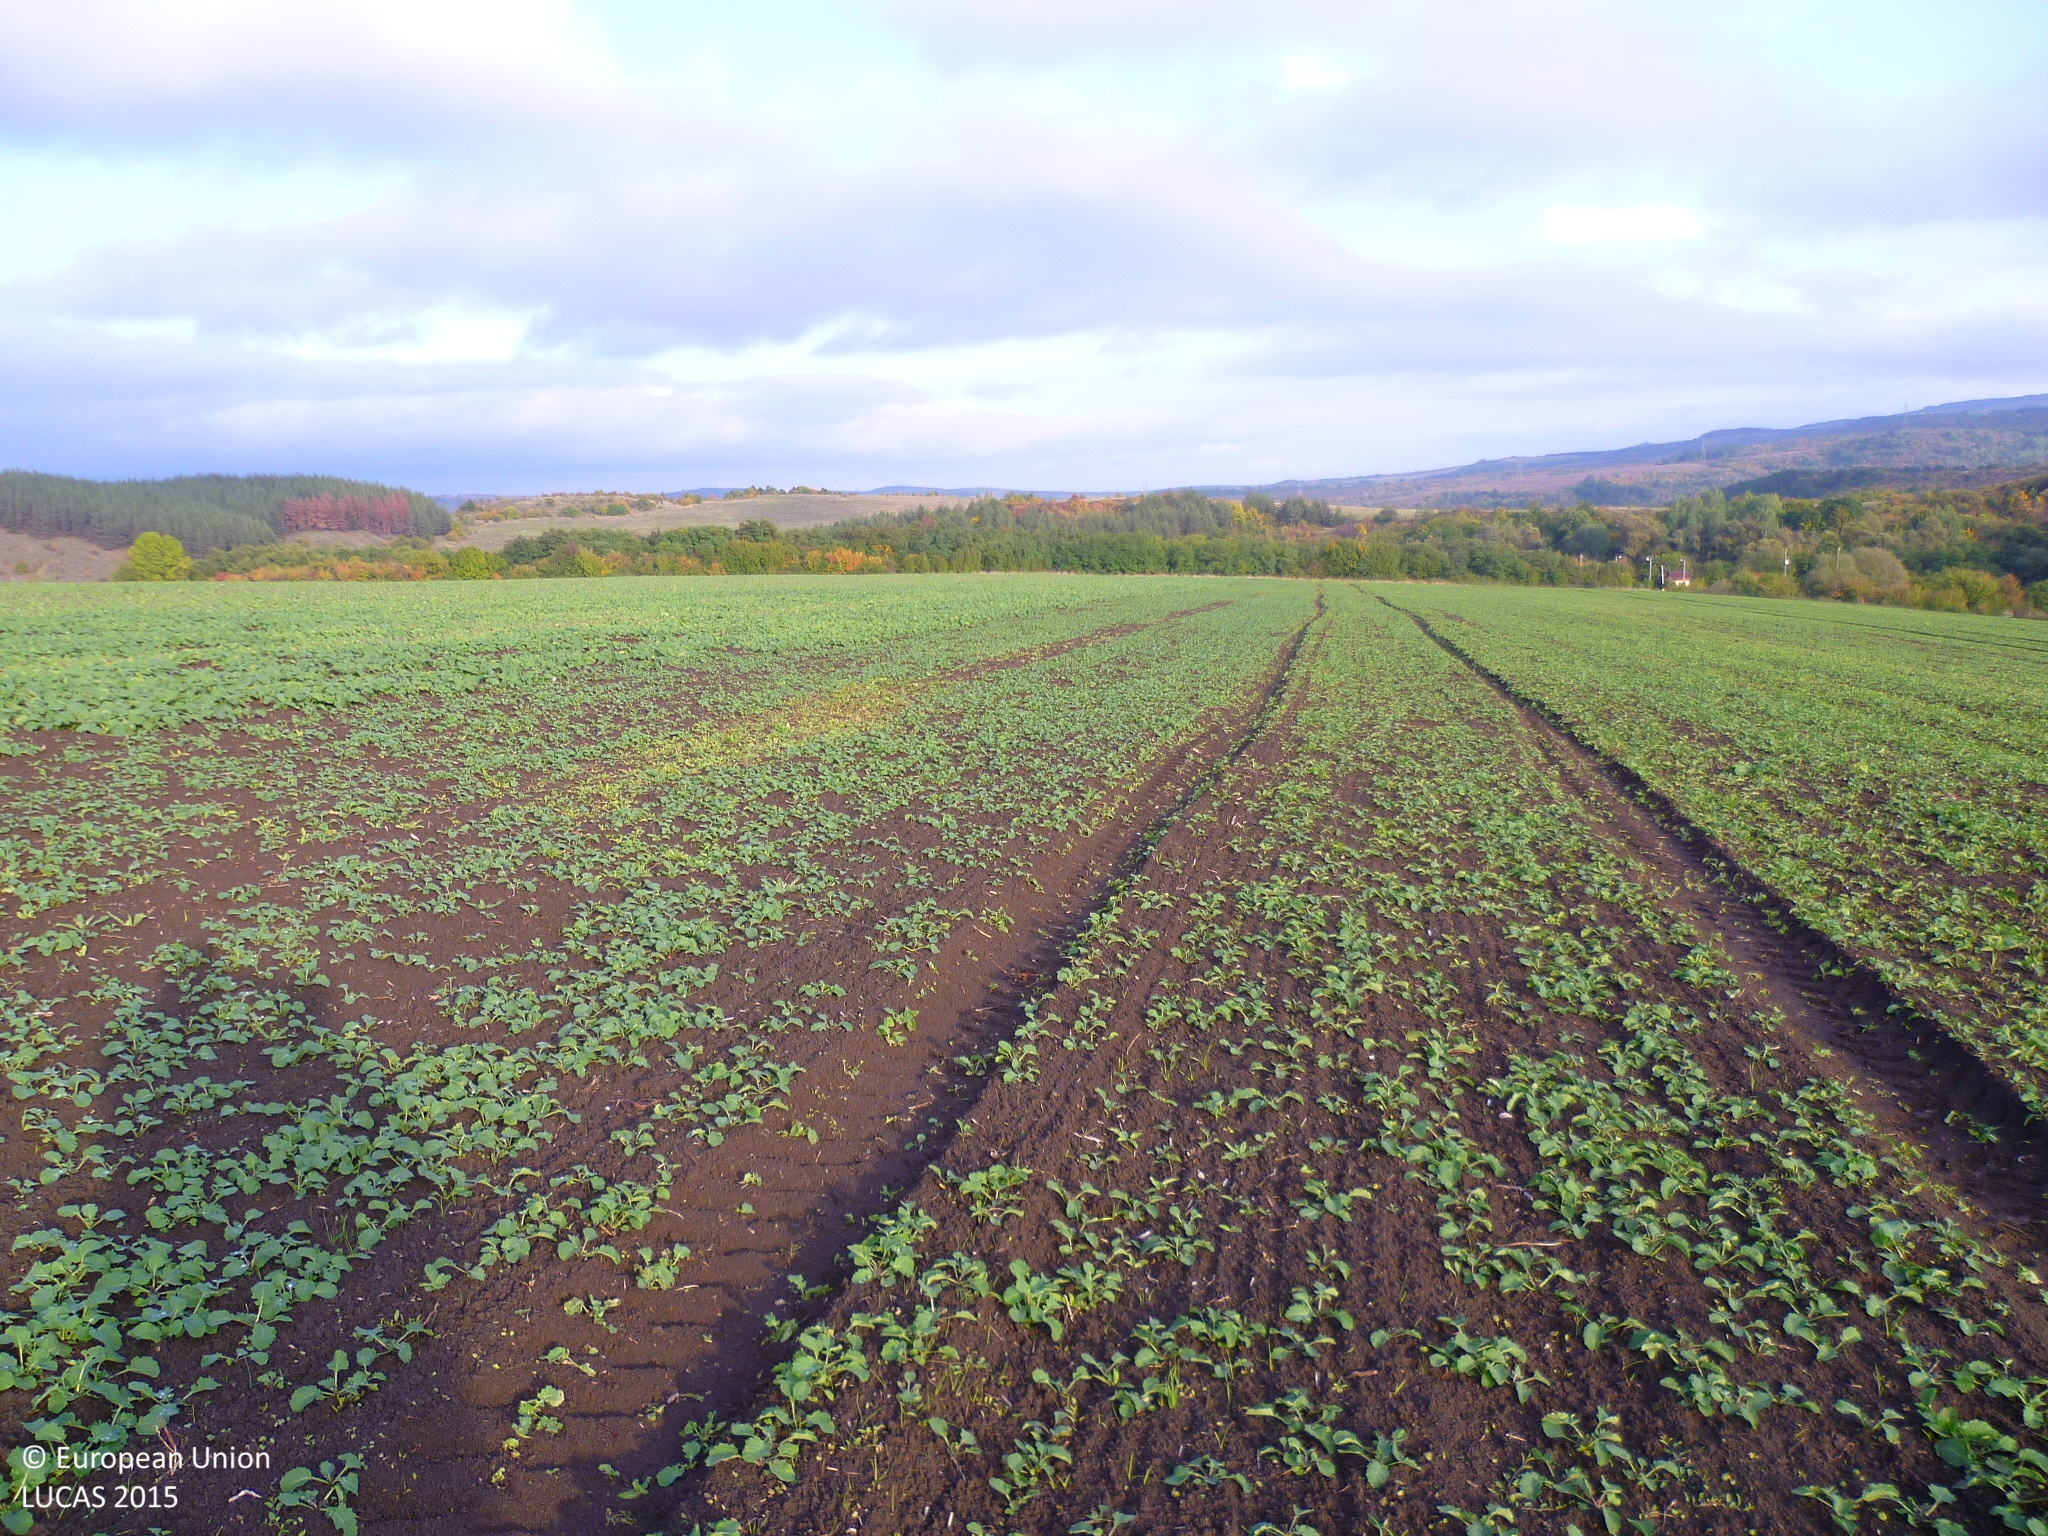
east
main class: Cropland
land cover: Rape and turnip rape
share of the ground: 50 - 75 %
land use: Agriculture (excluding fallow land and kitchen gardens)
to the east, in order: Rape and turnip rape
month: October
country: BG
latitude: 42.7596
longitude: 23.0196
